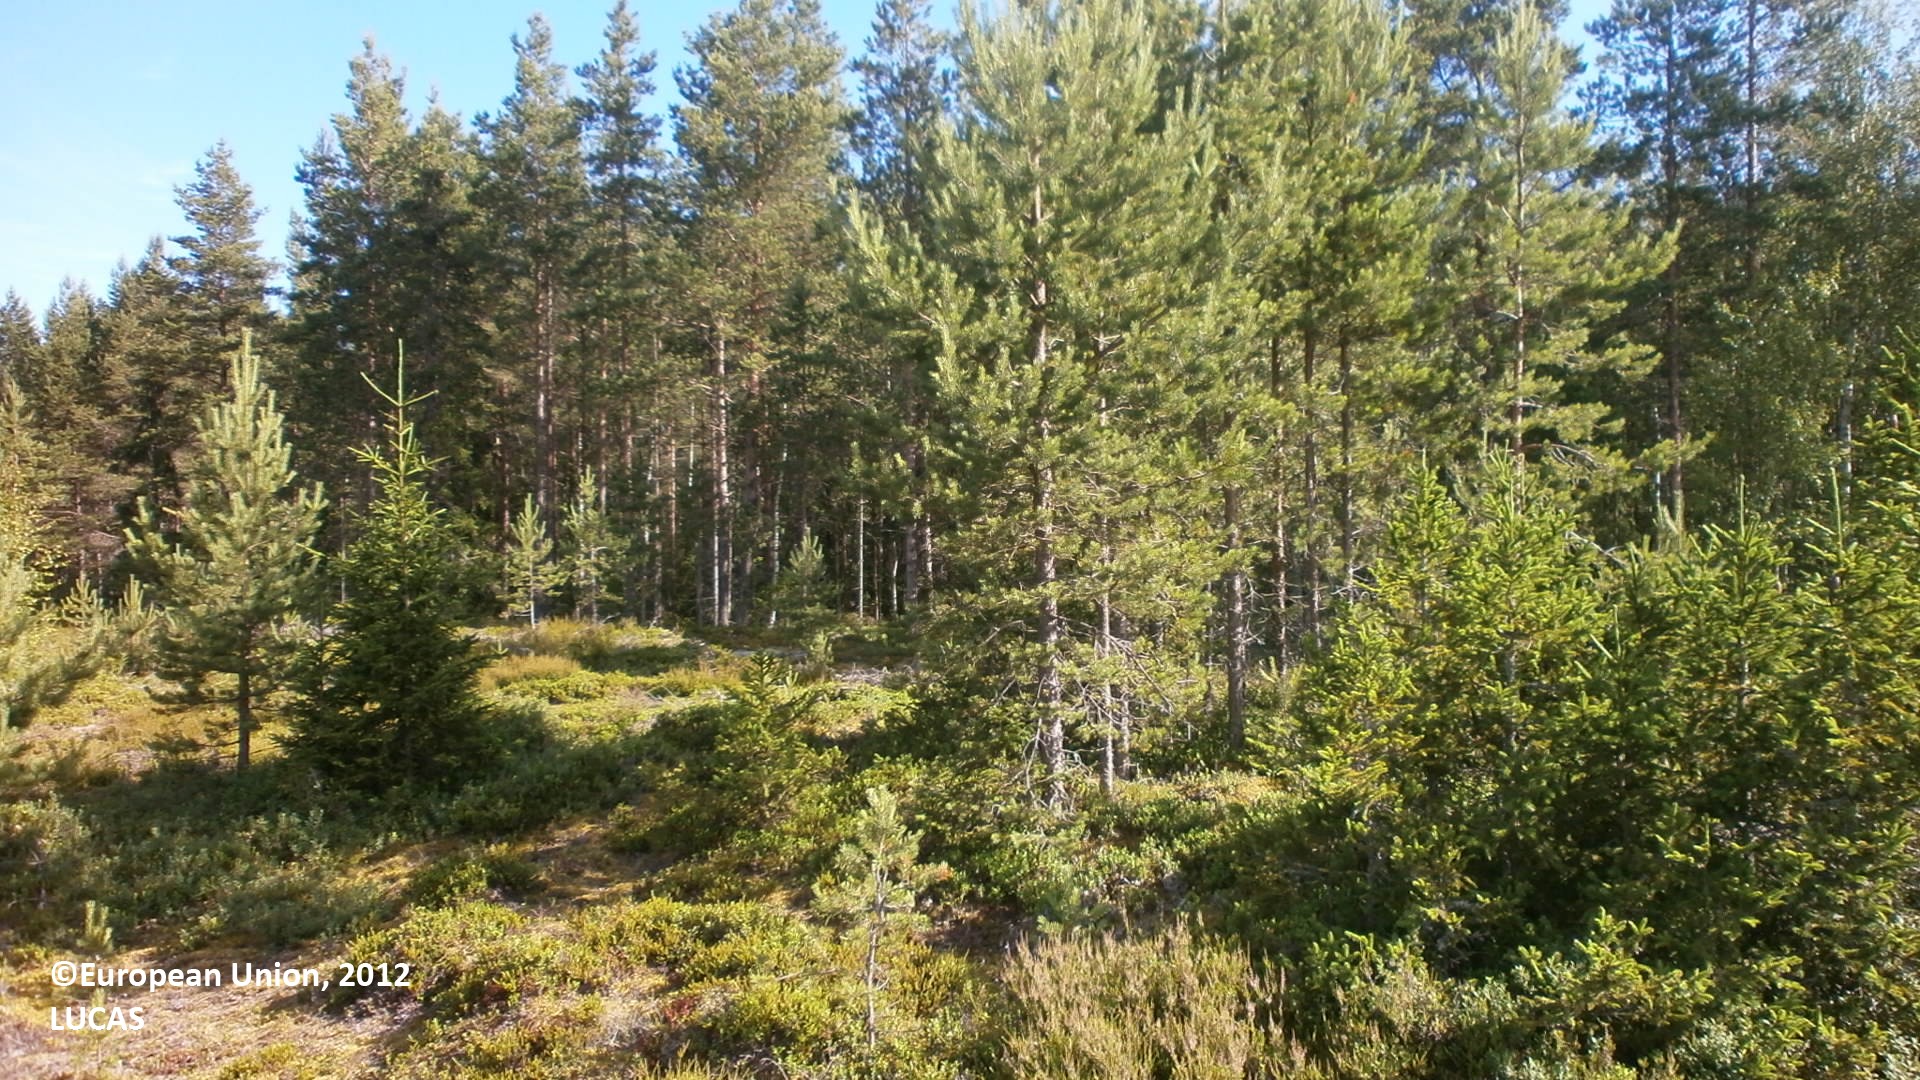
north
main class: Woodland
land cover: Pine dominated mixed woodland
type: boreal forest
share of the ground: 10 - 25 %
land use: Forestry
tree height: > 5 m
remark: Clear cut
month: July
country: FI
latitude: 64.4395
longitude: 24.1683
